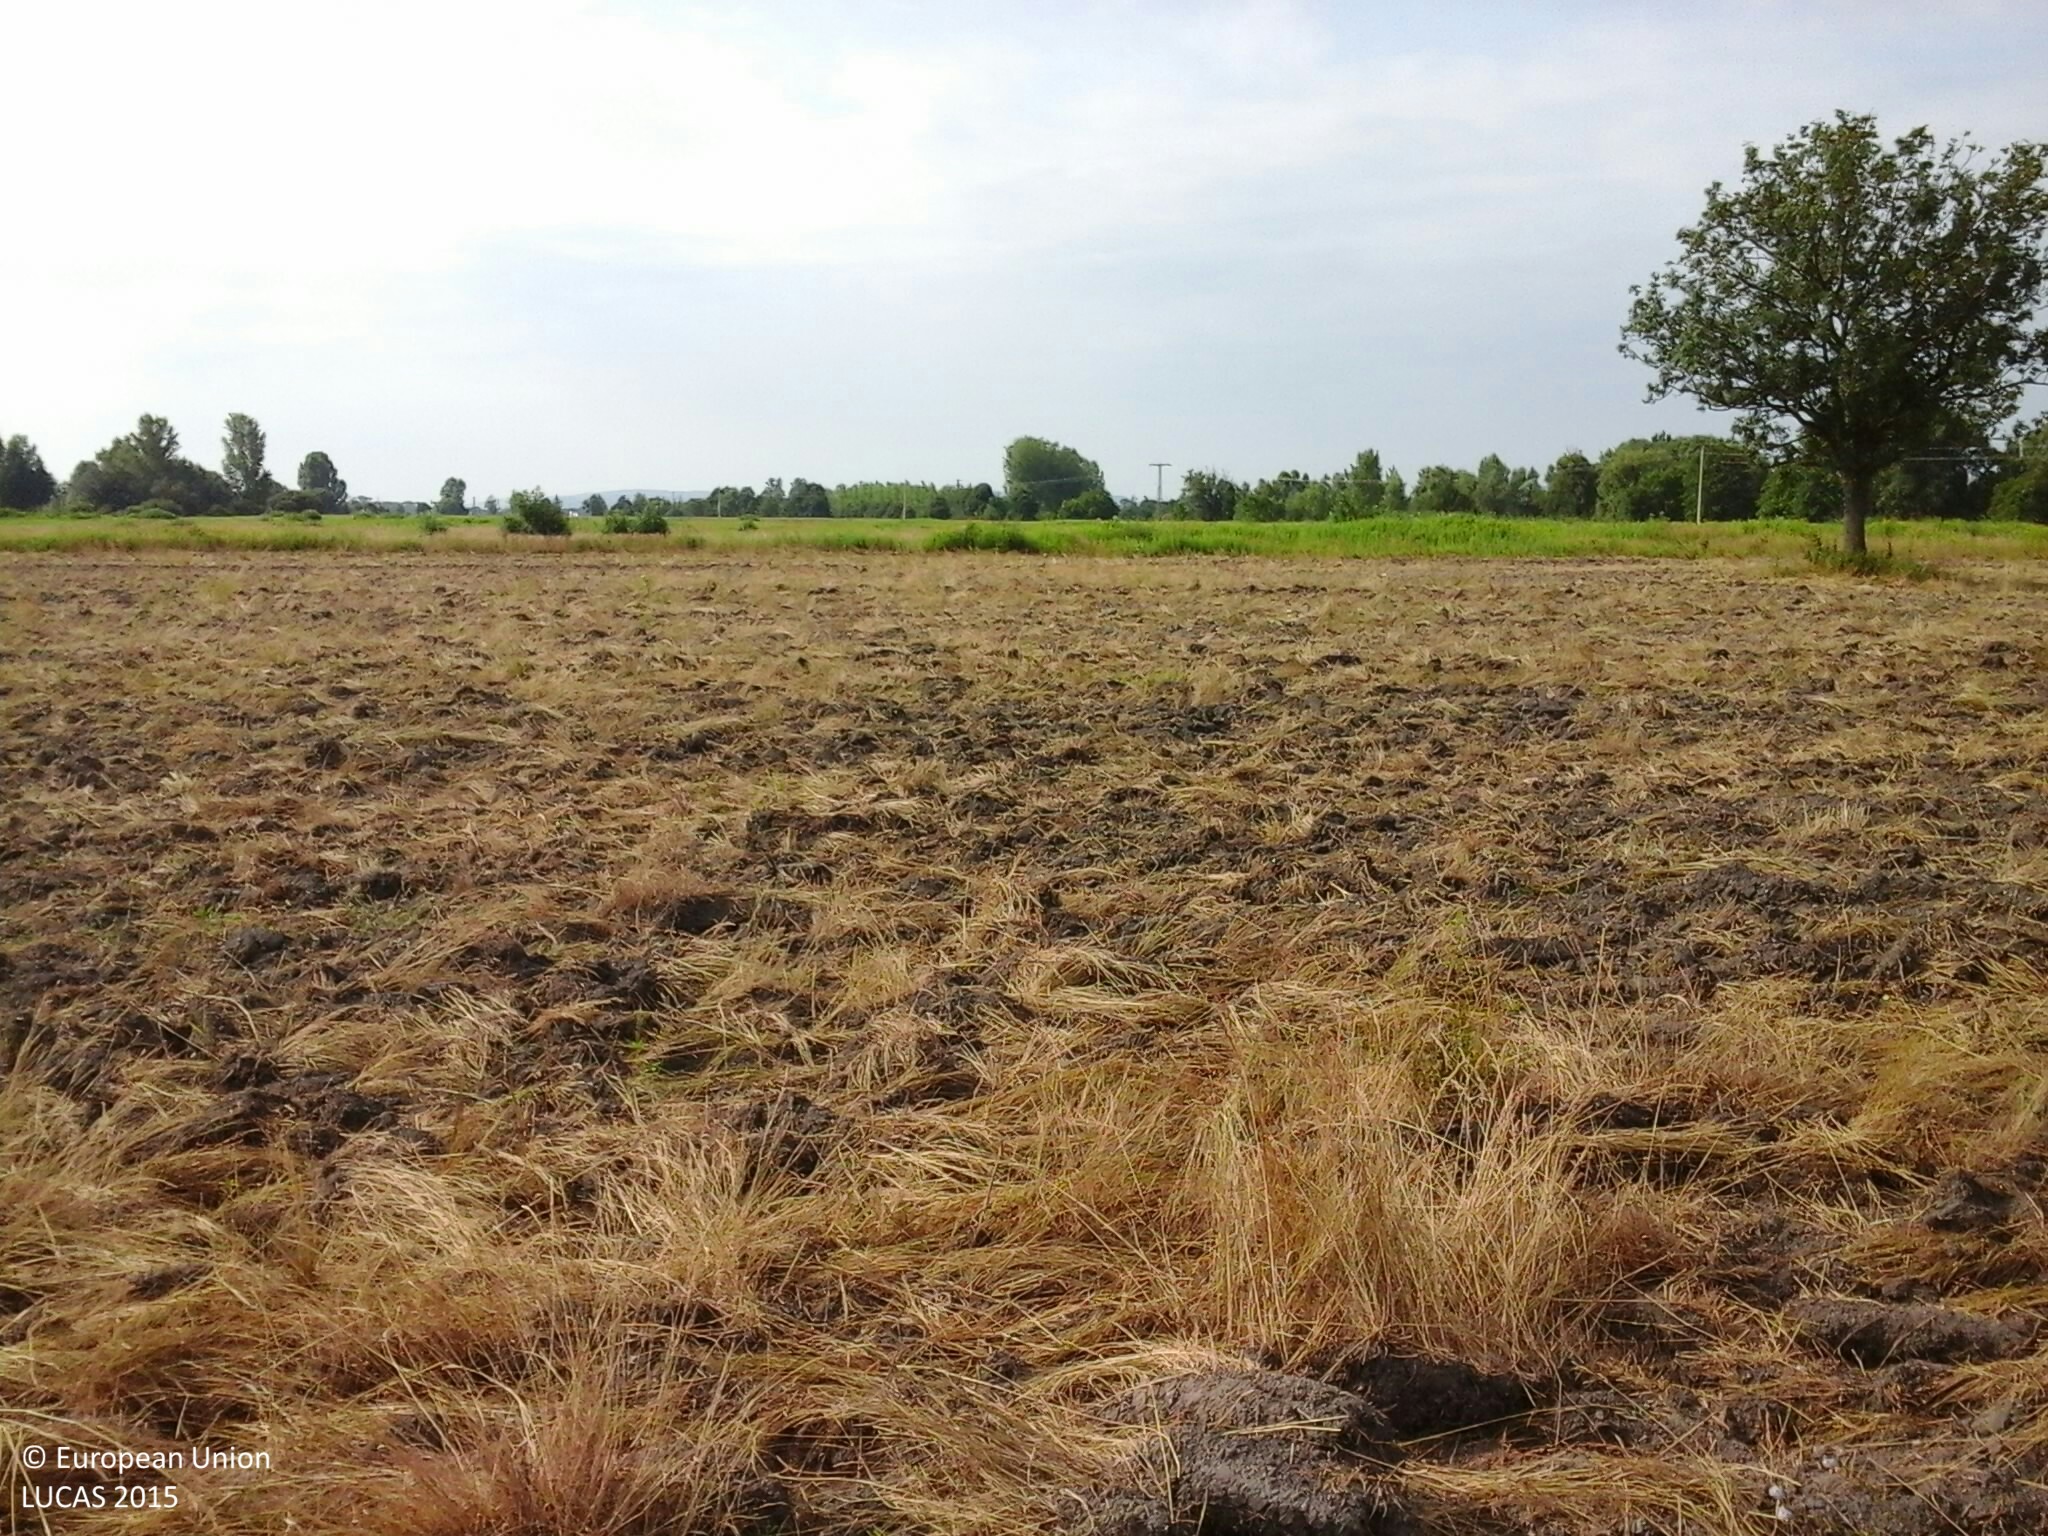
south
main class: Grassland
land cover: Grassland without tree/shrub cover
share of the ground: 50 - 75 %
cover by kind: herbaceous plants 50 %, unconsolidated bare surface 50 %
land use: Agriculture (excluding fallow land and kitchen gardens)
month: July
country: HU
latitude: 47.0284
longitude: 17.2292
